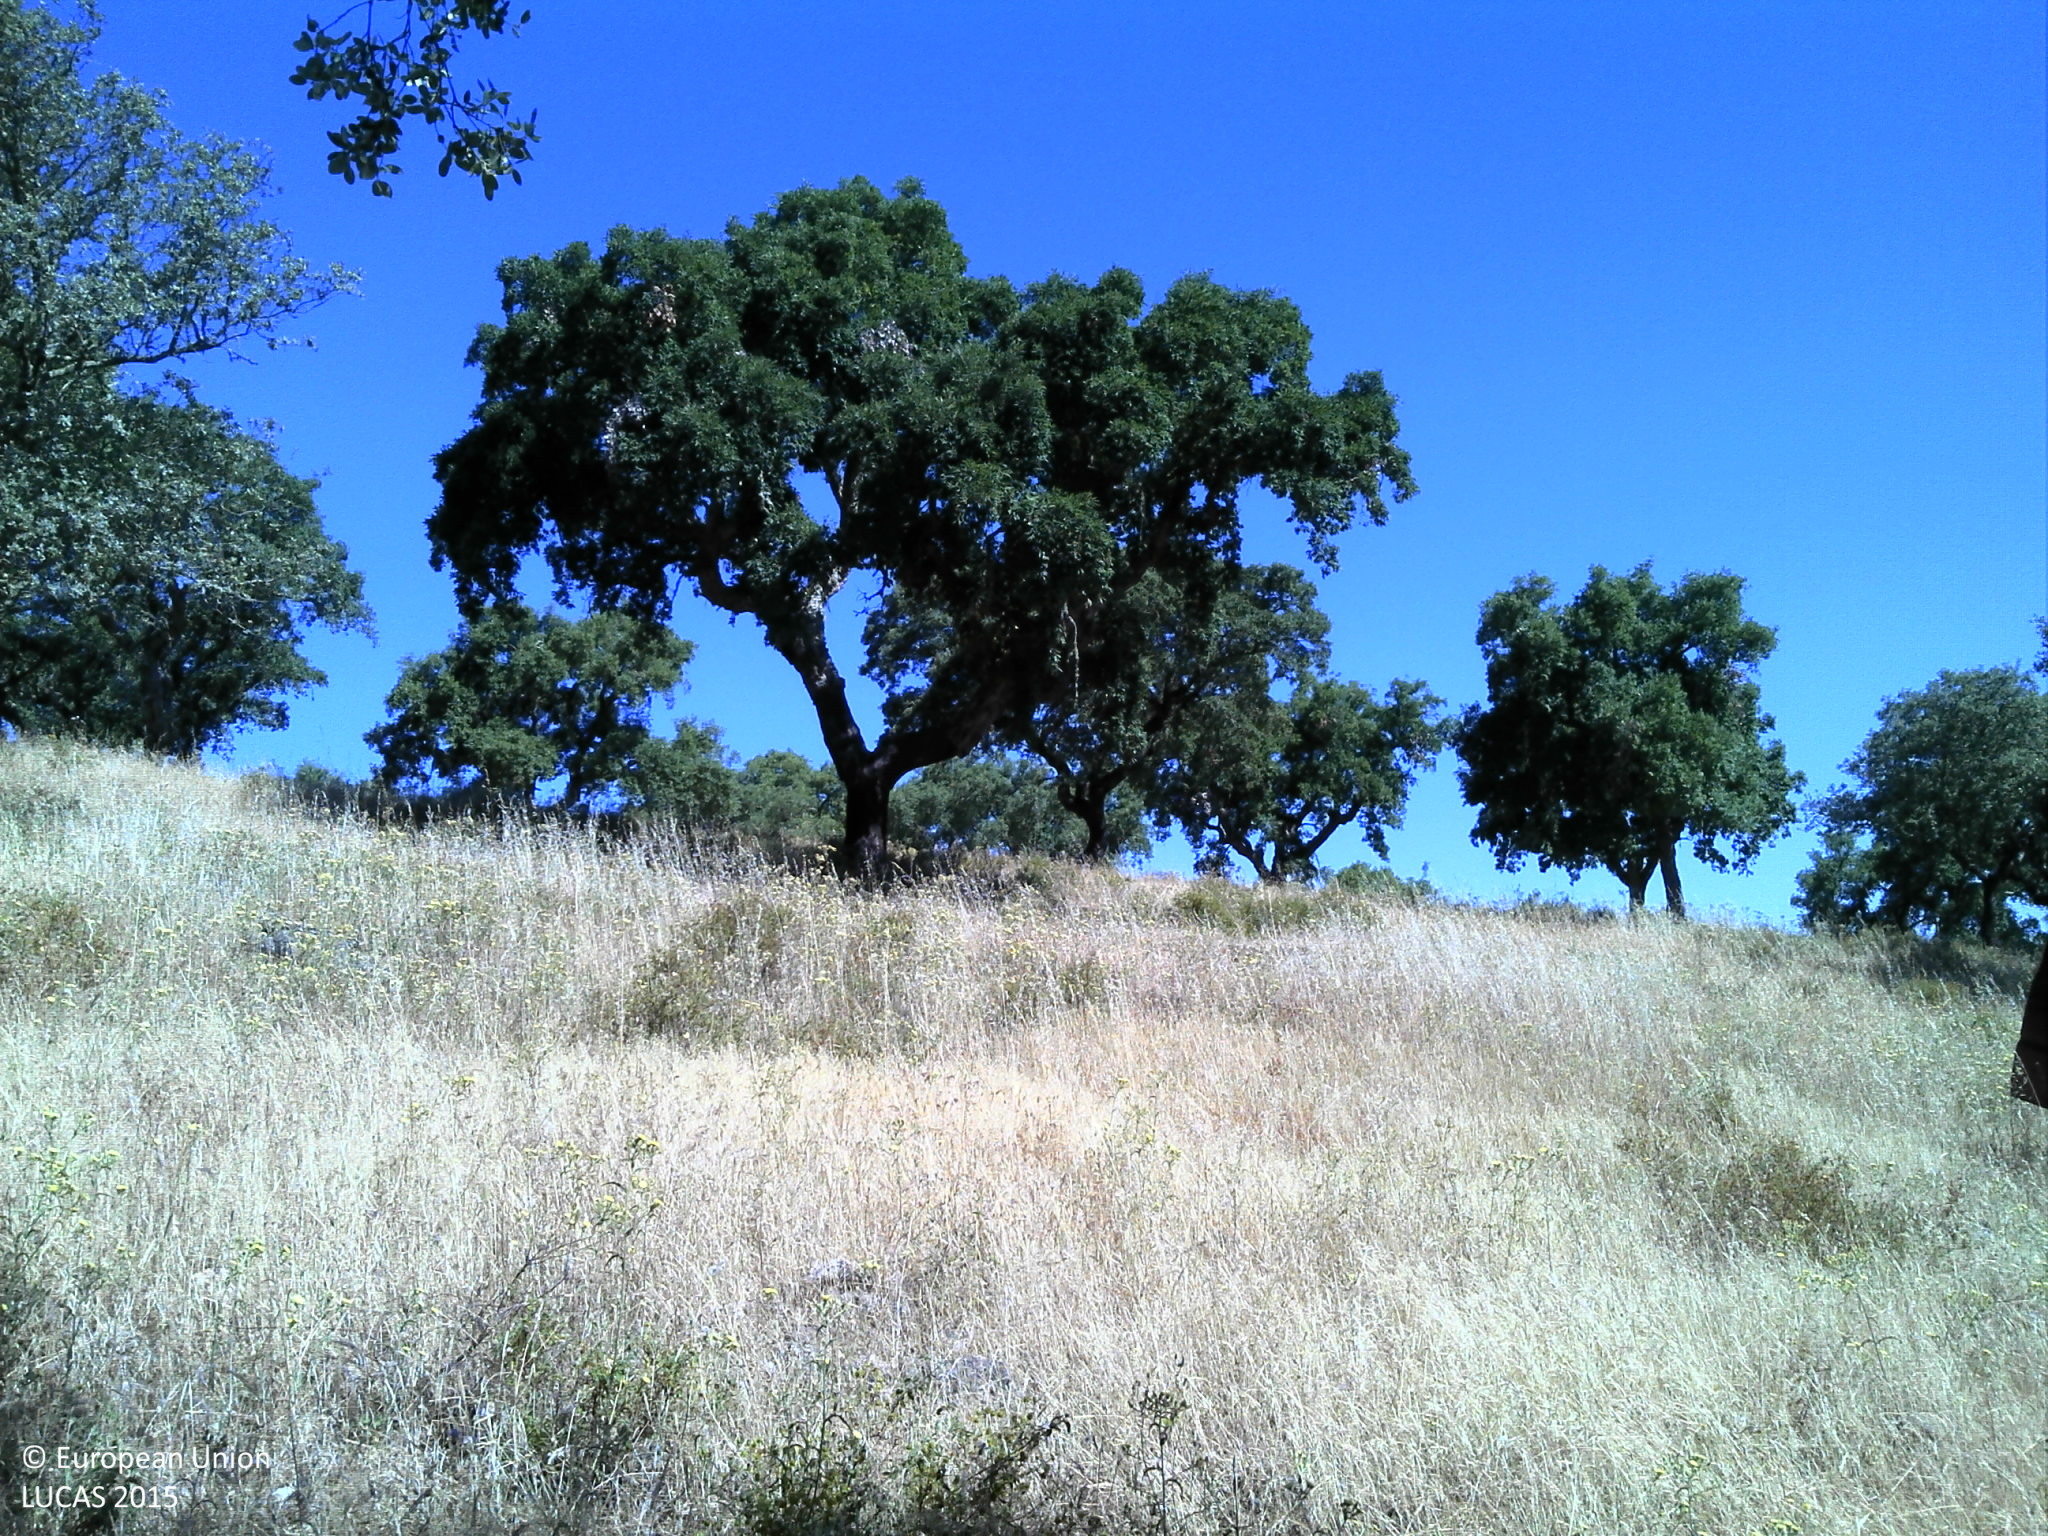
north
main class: Woodland
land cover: Broadleaved woodland
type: broadleaved evergreen forest
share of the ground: 50 - 75 %
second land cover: Grassland without tree/shrub cover
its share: 25 - 50 %
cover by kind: broadleaved forest trees 50 %, herbaceous plants 40 %, unconsolidated bare surface 10 %
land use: Forestry
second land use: Agriculture (excluding fallow land and kitchen gardens)
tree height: > 5 m
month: June
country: PT
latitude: 38.7790
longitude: -8.1564
